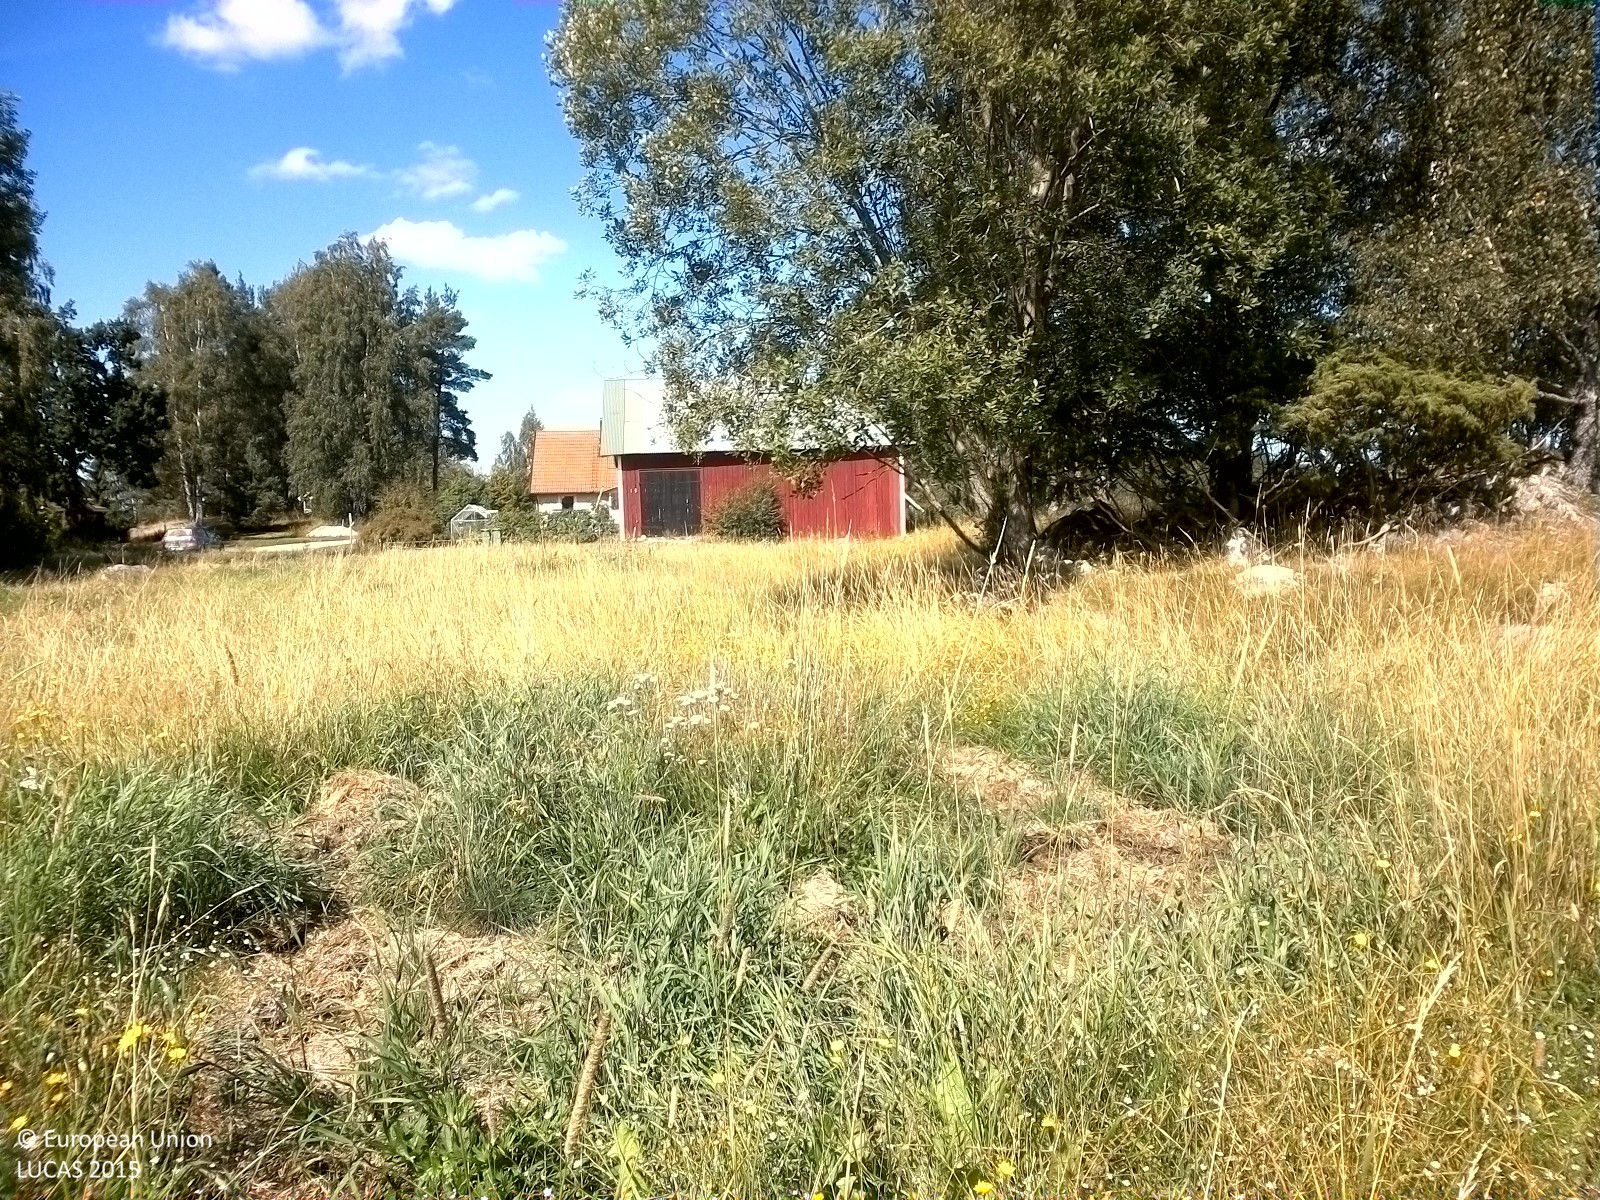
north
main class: Grassland
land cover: Grassland without tree/shrub cover
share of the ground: > 75 %
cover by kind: herbaceous plants 100 %
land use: Agriculture (excluding fallow land and kitchen gardens)
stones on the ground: 10 - 25 %
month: August
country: SE
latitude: 59.4164
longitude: 15.2246
